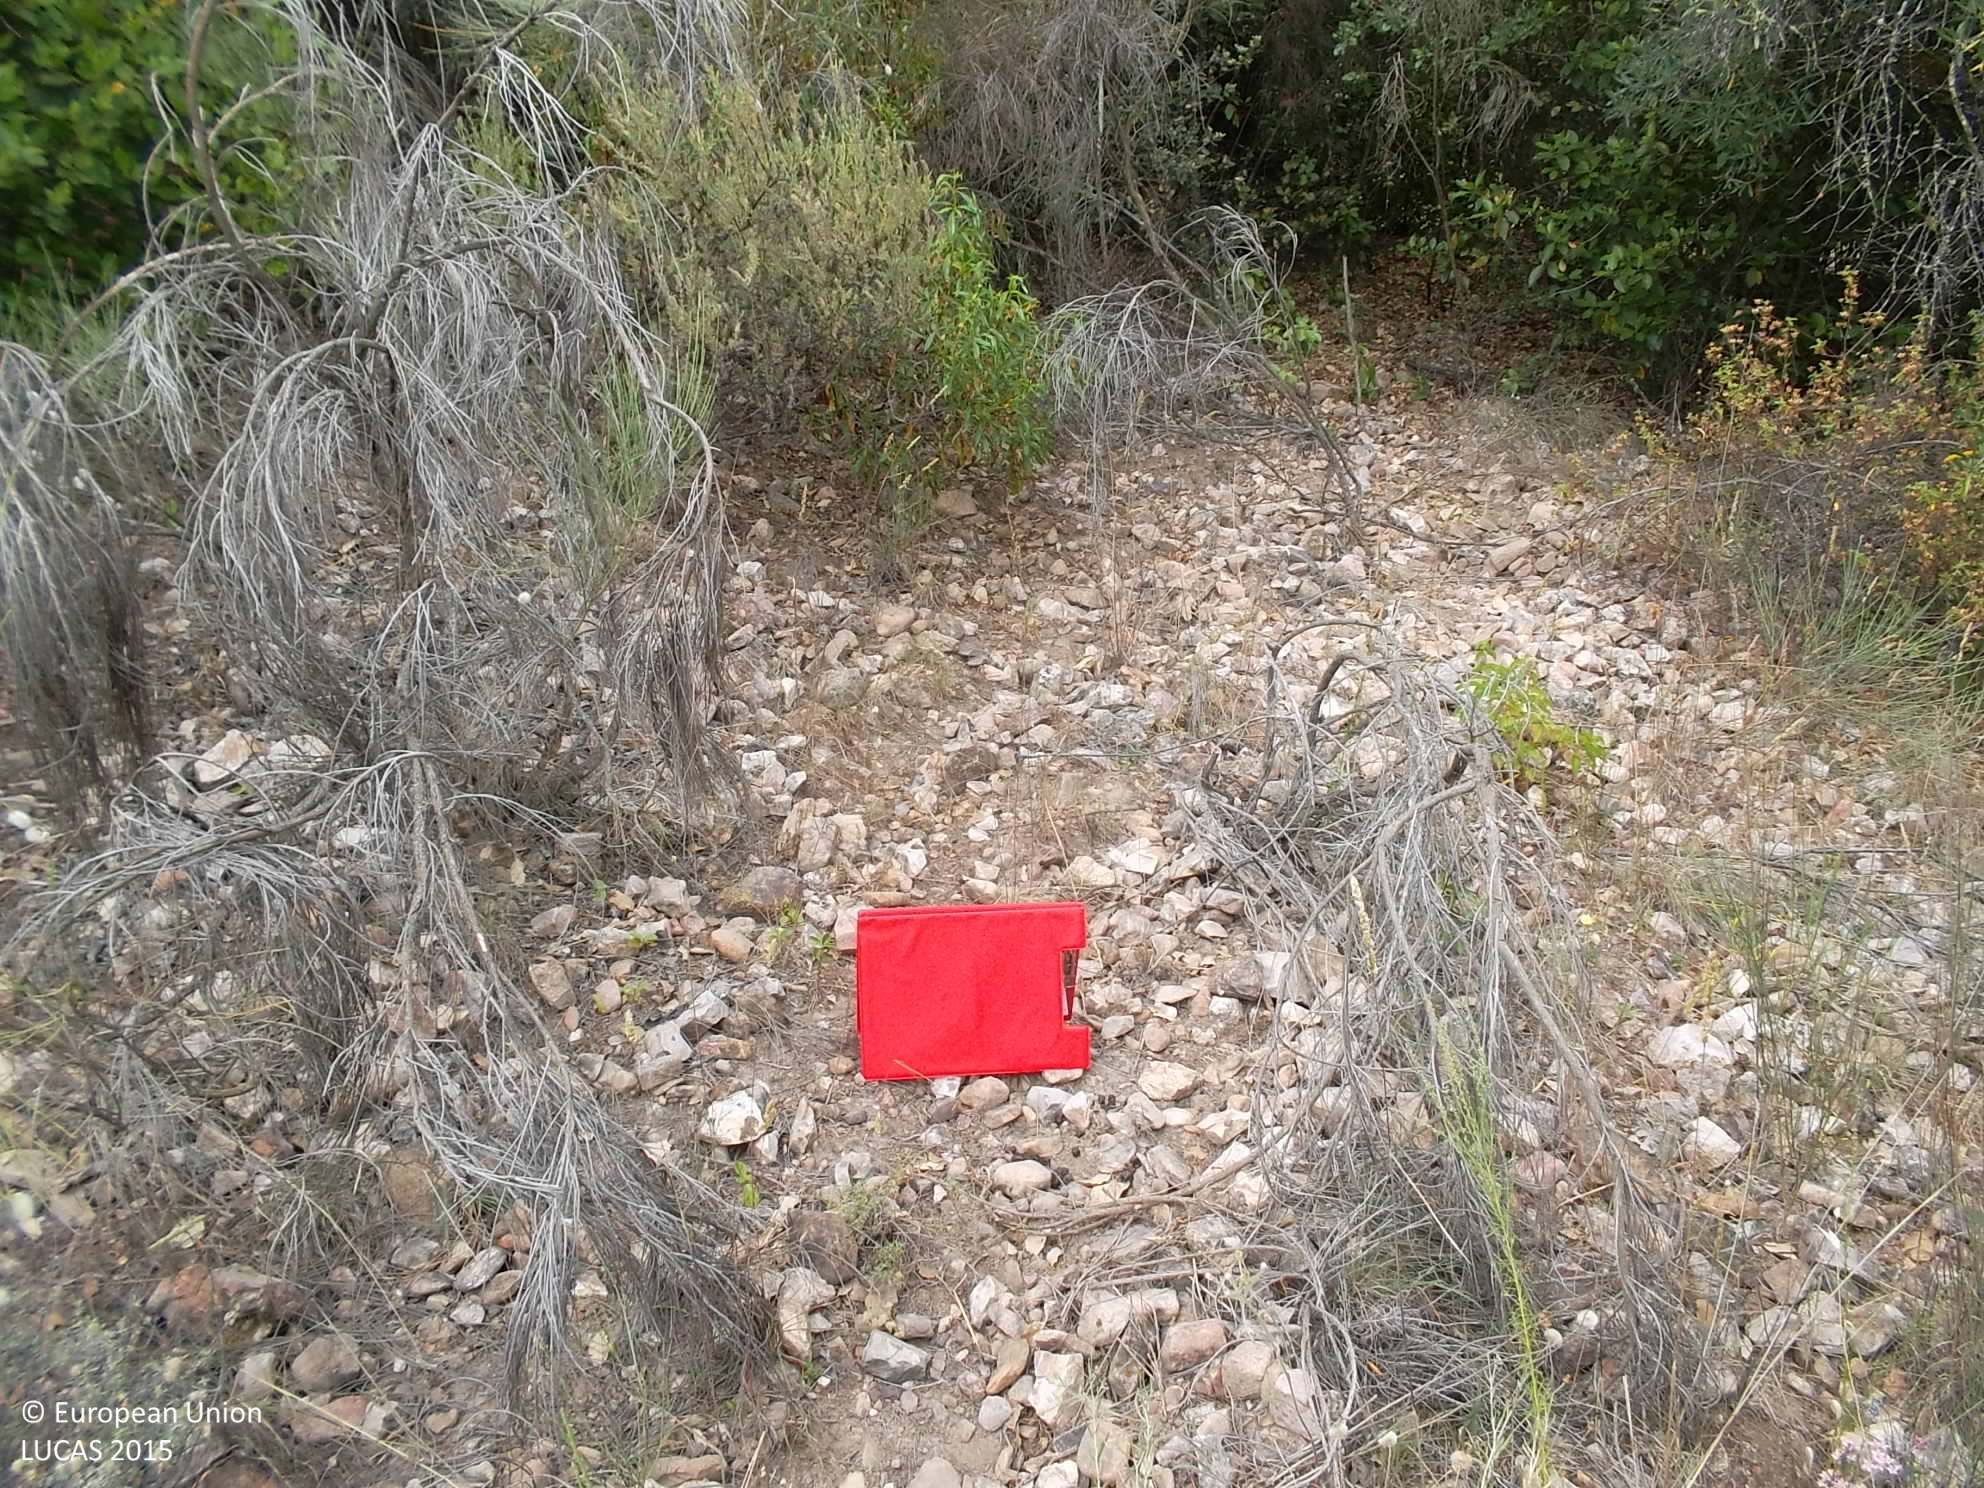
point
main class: Cropland
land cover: Olive groves
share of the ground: 25 - 50 %
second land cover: Shrubland without tree cover
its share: 50 - 75 %
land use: Agriculture (excluding fallow land and kitchen gardens)
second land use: Forestry
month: June
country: ES
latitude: 39.2111
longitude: -4.8019
